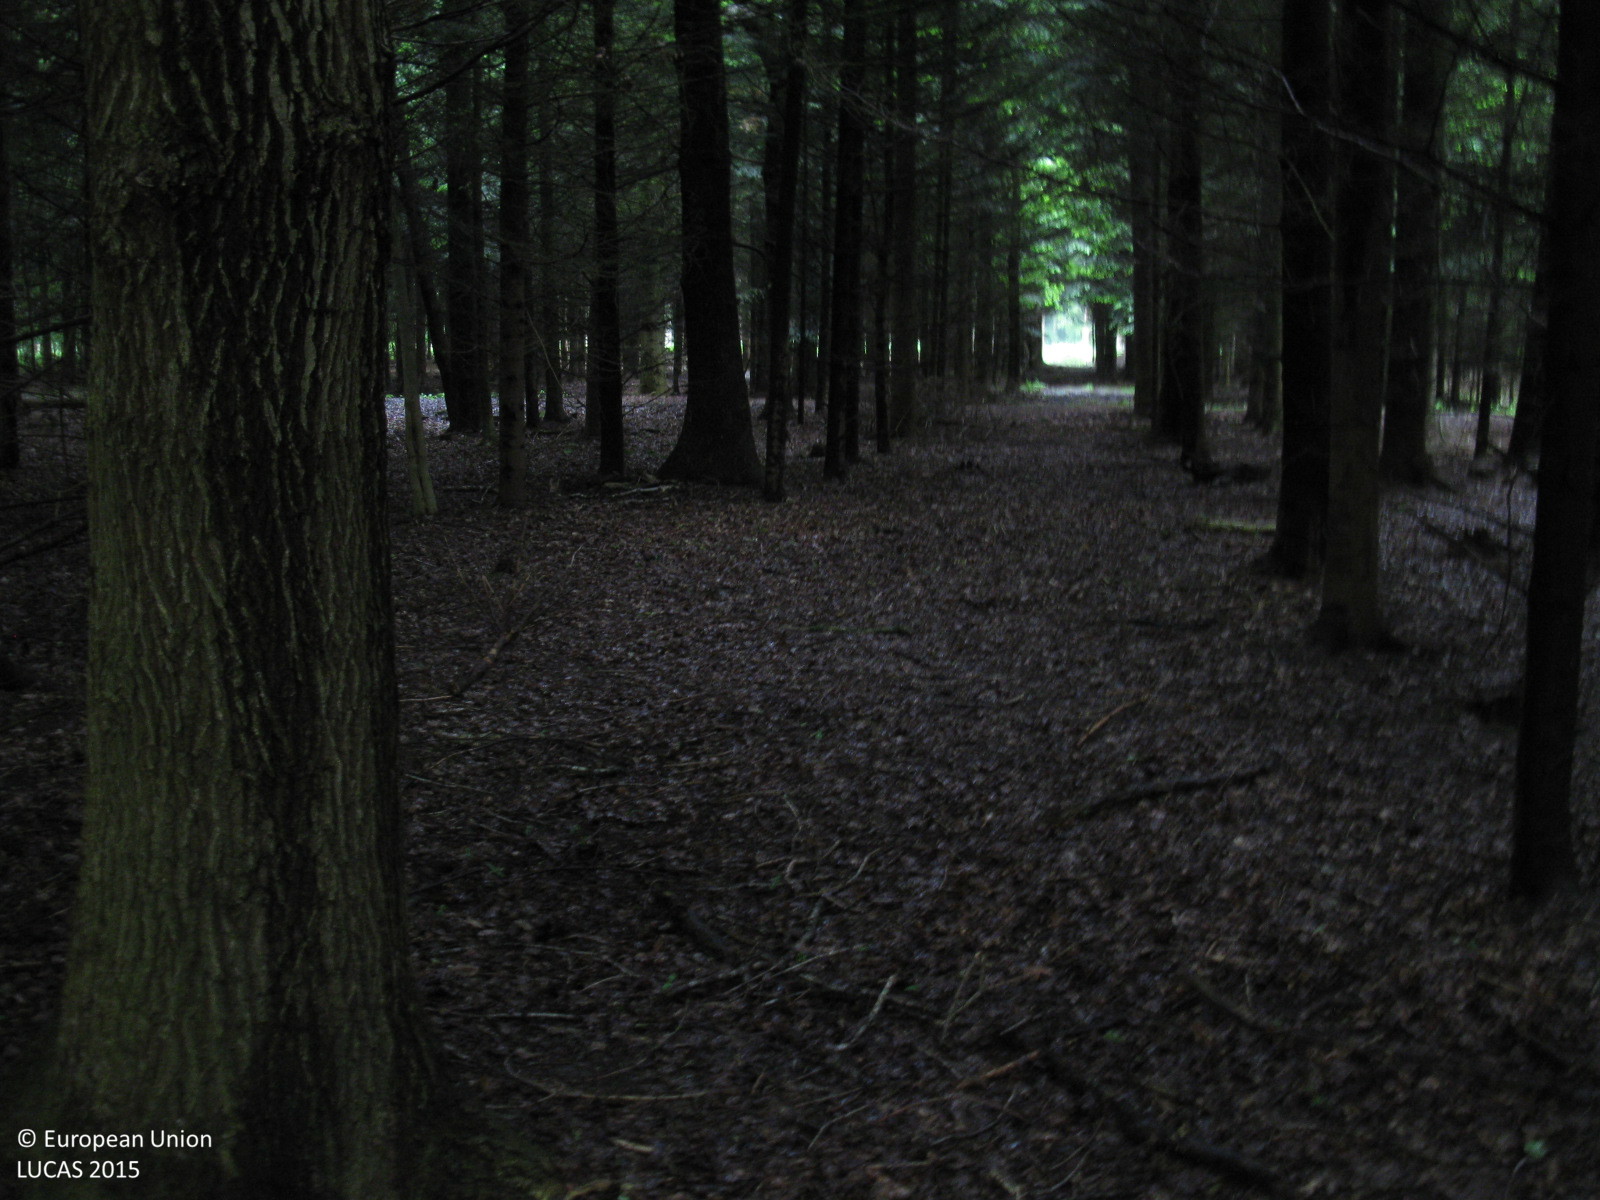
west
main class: Woodland
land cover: Spruce dominated mixed woodland
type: hemiboreal forest and nemoral coniferous forest and mixed broadleaved-coniferous forest
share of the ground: > 75 %
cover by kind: coniferous forest trees 70 %, broadleaved forest trees 30 %
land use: Forestry
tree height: > 5 m
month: June
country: DE
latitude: 53.6228
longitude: 7.2641
